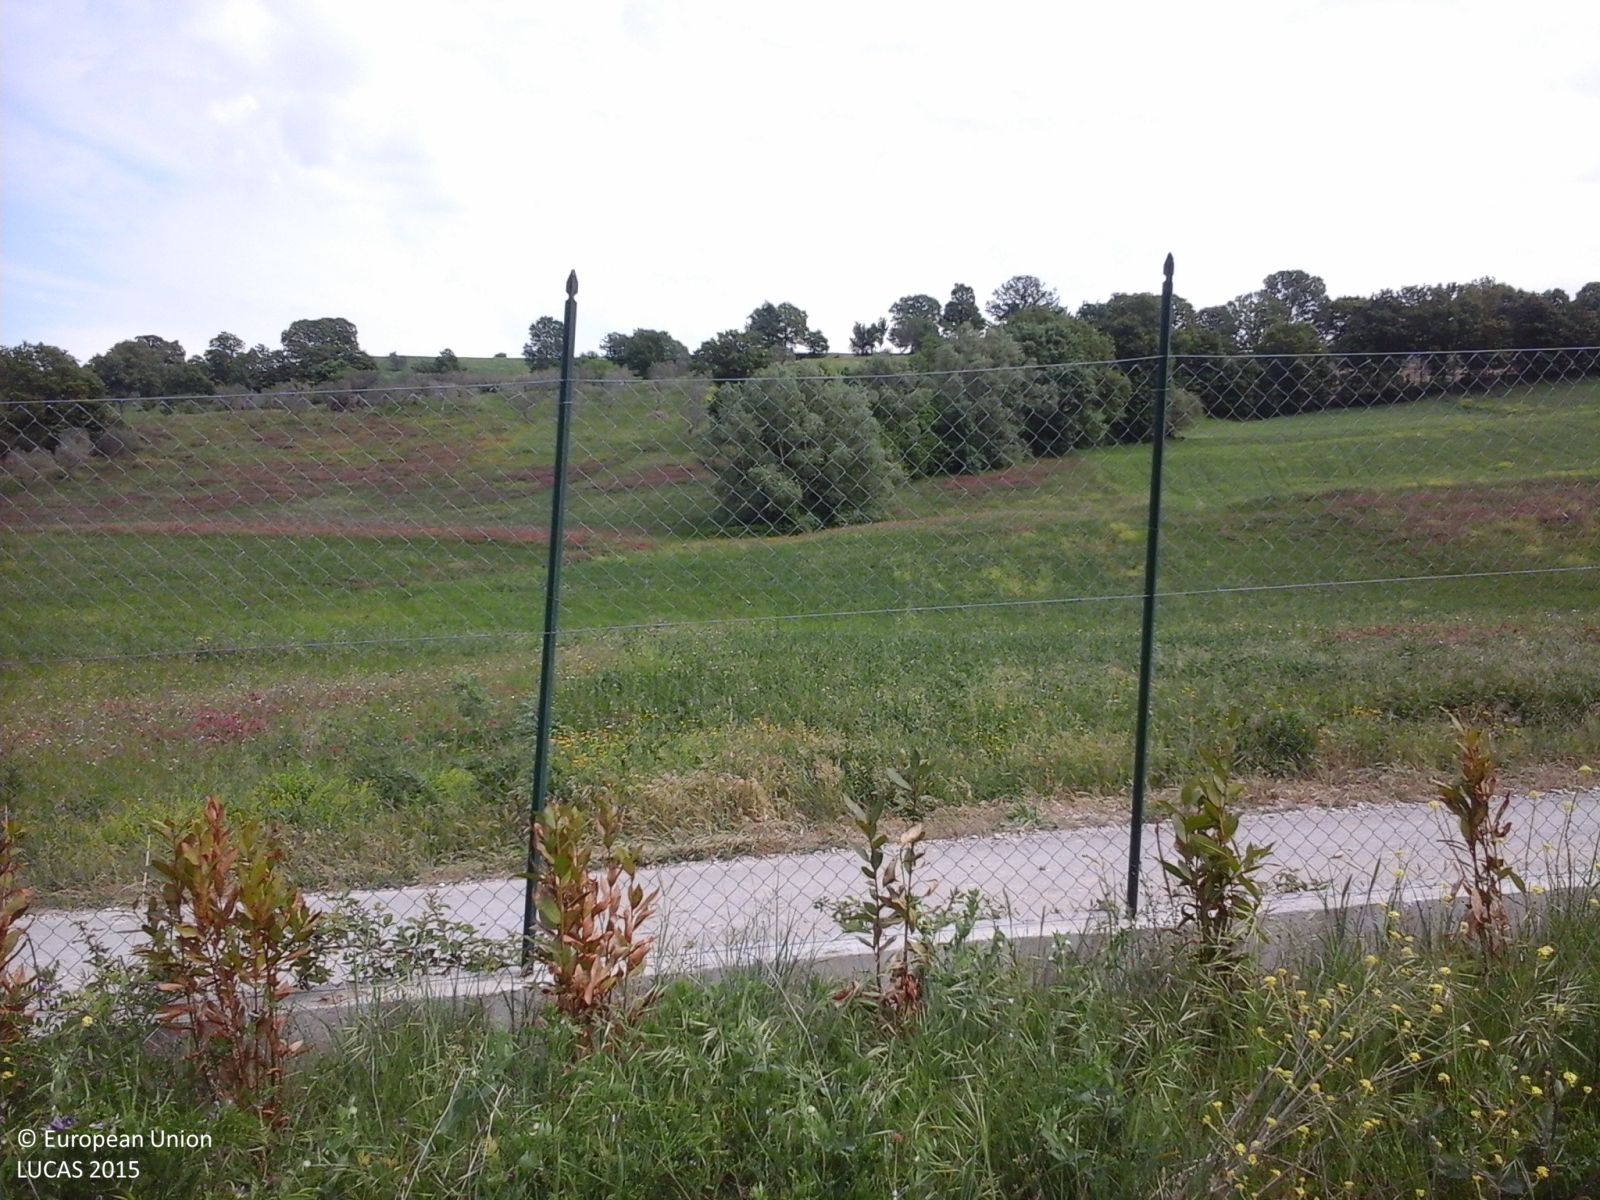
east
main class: Grassland
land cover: Spontaneously vegetated surfaces
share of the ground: > 75 %
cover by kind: herbaceous plants 95 %, unconsolidated bare surface 5 %
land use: Fallow land
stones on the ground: 10 - 25 %
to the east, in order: Spontaneously vegetated surfaces; Lines of trees; Fences; Grass margins; Paved roads, cycling and walking lanes; Grass margins; Ditches and canals; Spontaneously vegetated surfaces; Ditches and canals; Other leguminous and mixtures for fodder; Single bushes/trees; Other leguminous and mixtures for fodder; Olive groves
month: May
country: IT
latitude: 41.3672
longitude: 14.7291
